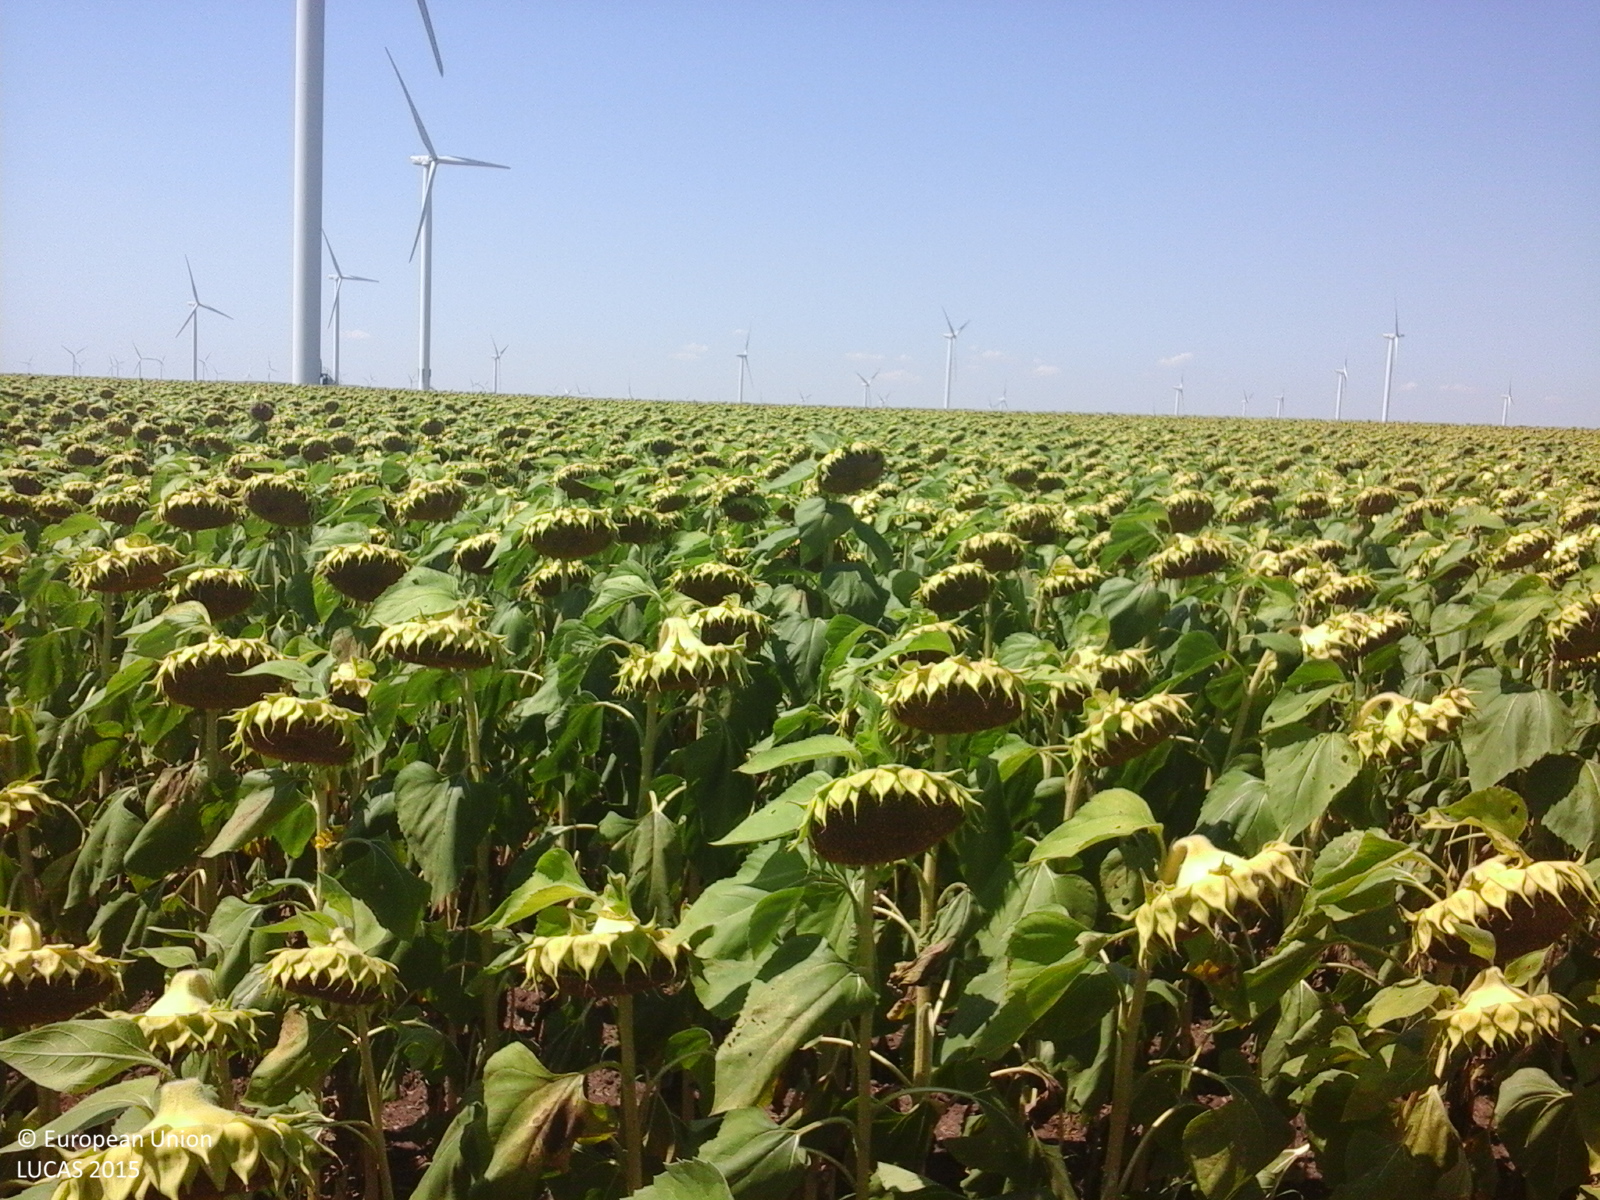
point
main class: Cropland
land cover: Sunflower
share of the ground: > 75 %
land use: Agriculture (excluding fallow land and kitchen gardens)
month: August
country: RO
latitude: 44.6063
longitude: 28.6124
